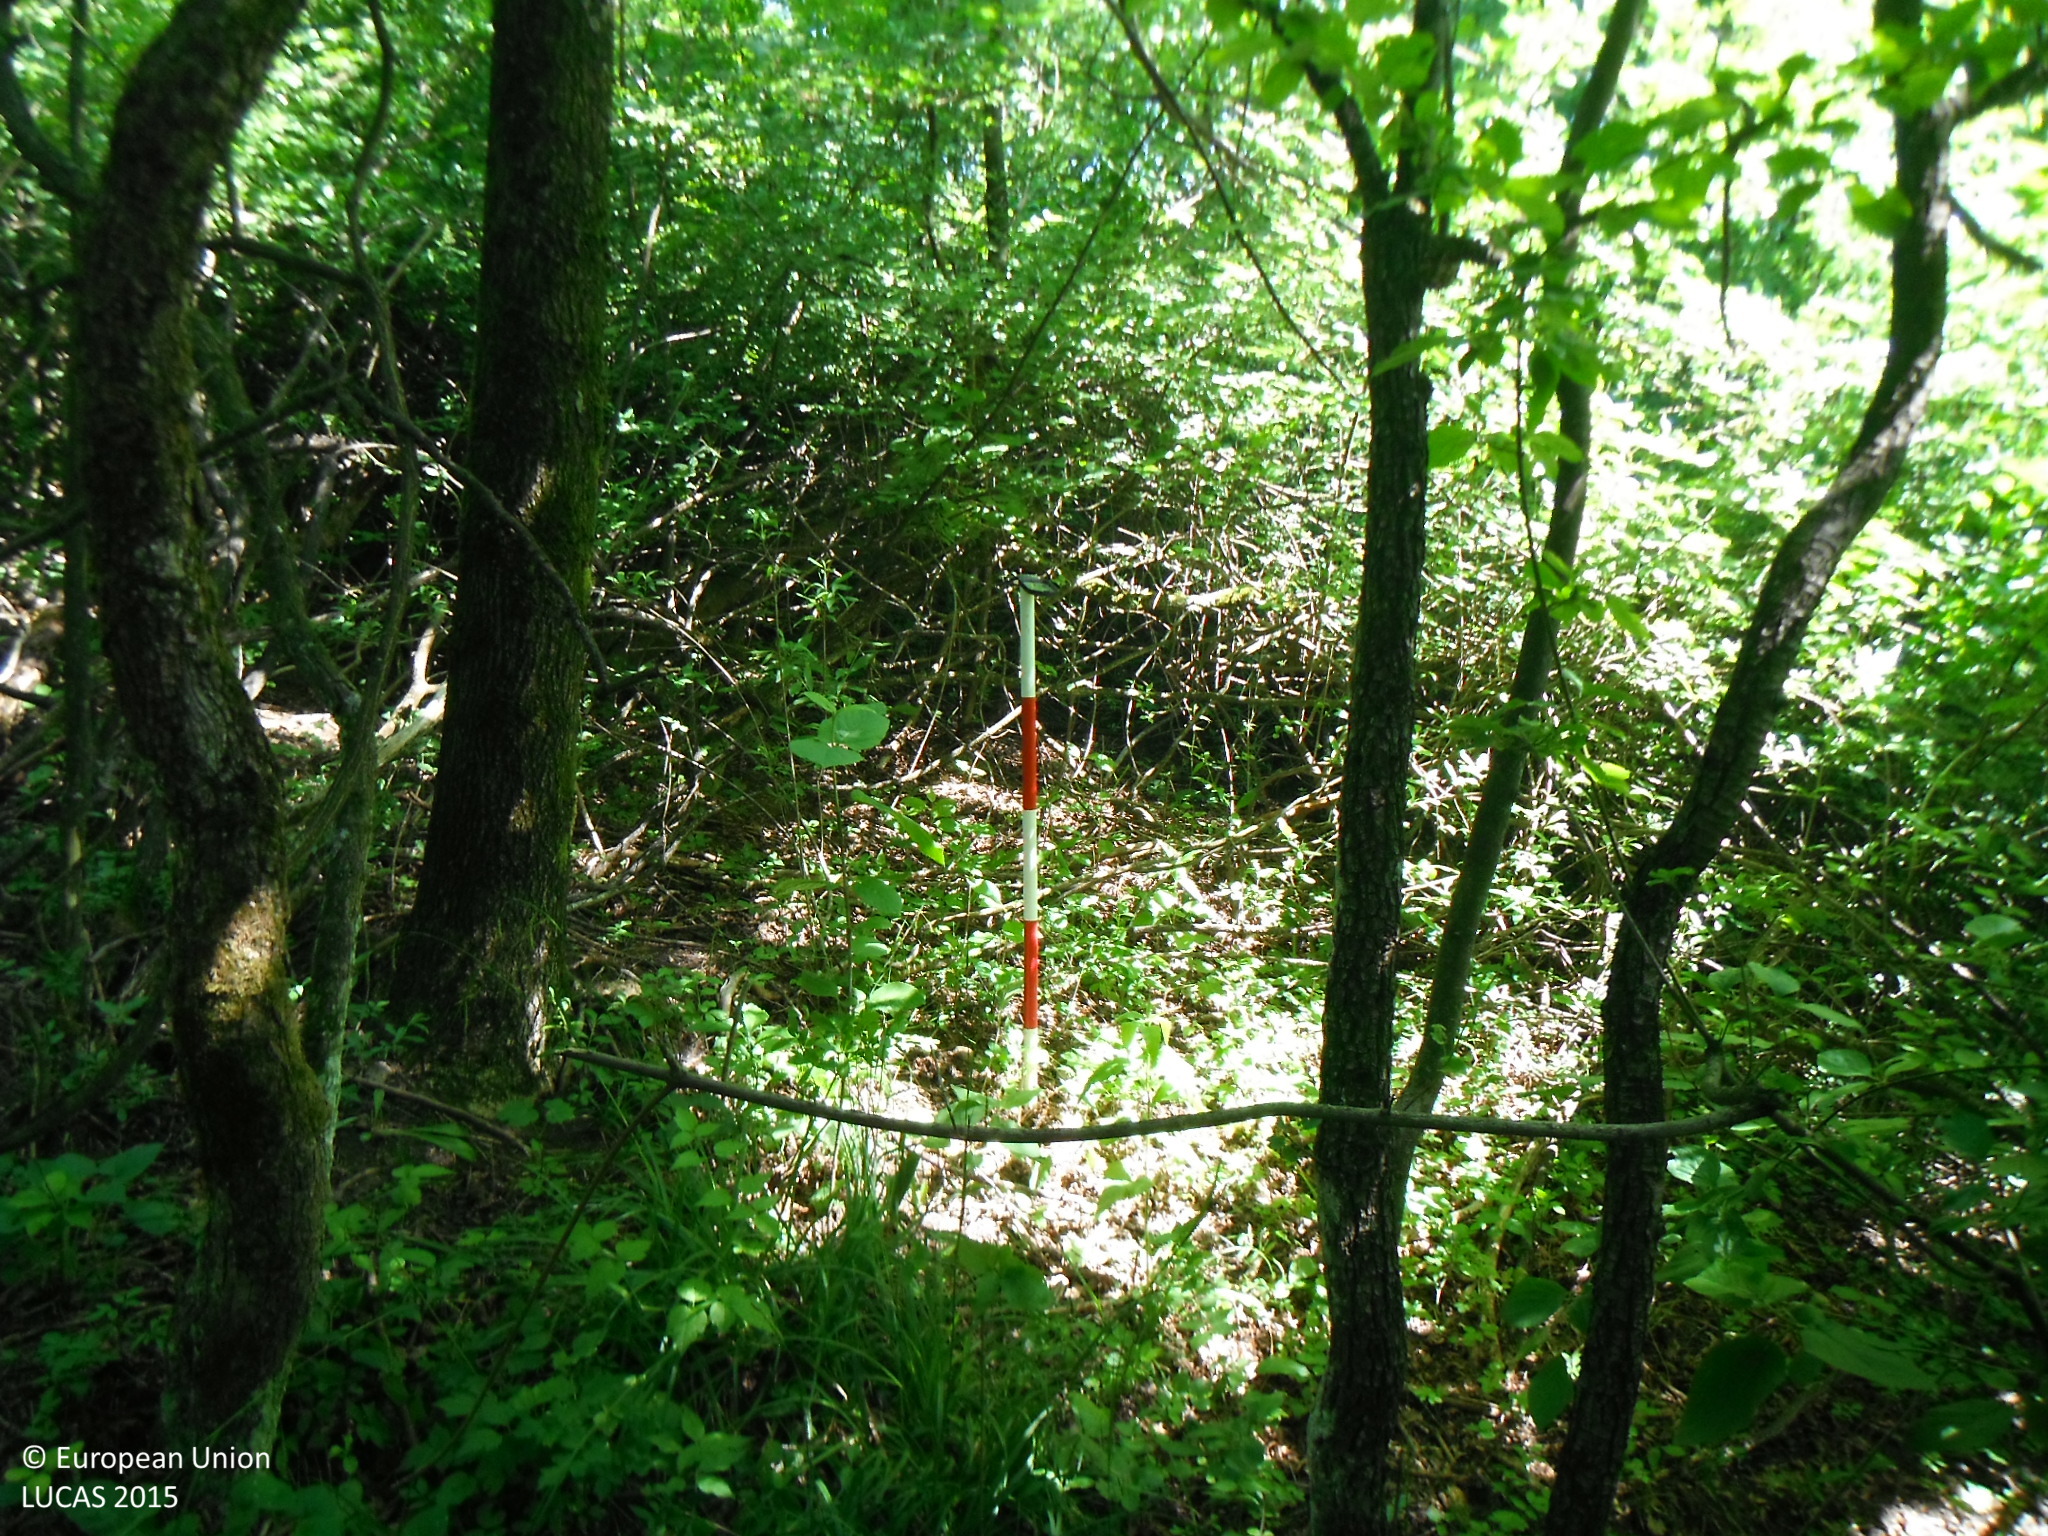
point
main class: Woodland
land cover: Broadleaved woodland
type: mesophytic deciduous forest
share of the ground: > 75 %
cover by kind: broadleaved forest trees 90 %, shrubs 10 %
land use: Semi-natural and natural areas not in use
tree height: > 5 m
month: June
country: SK
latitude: 48.5711
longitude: 17.3964
